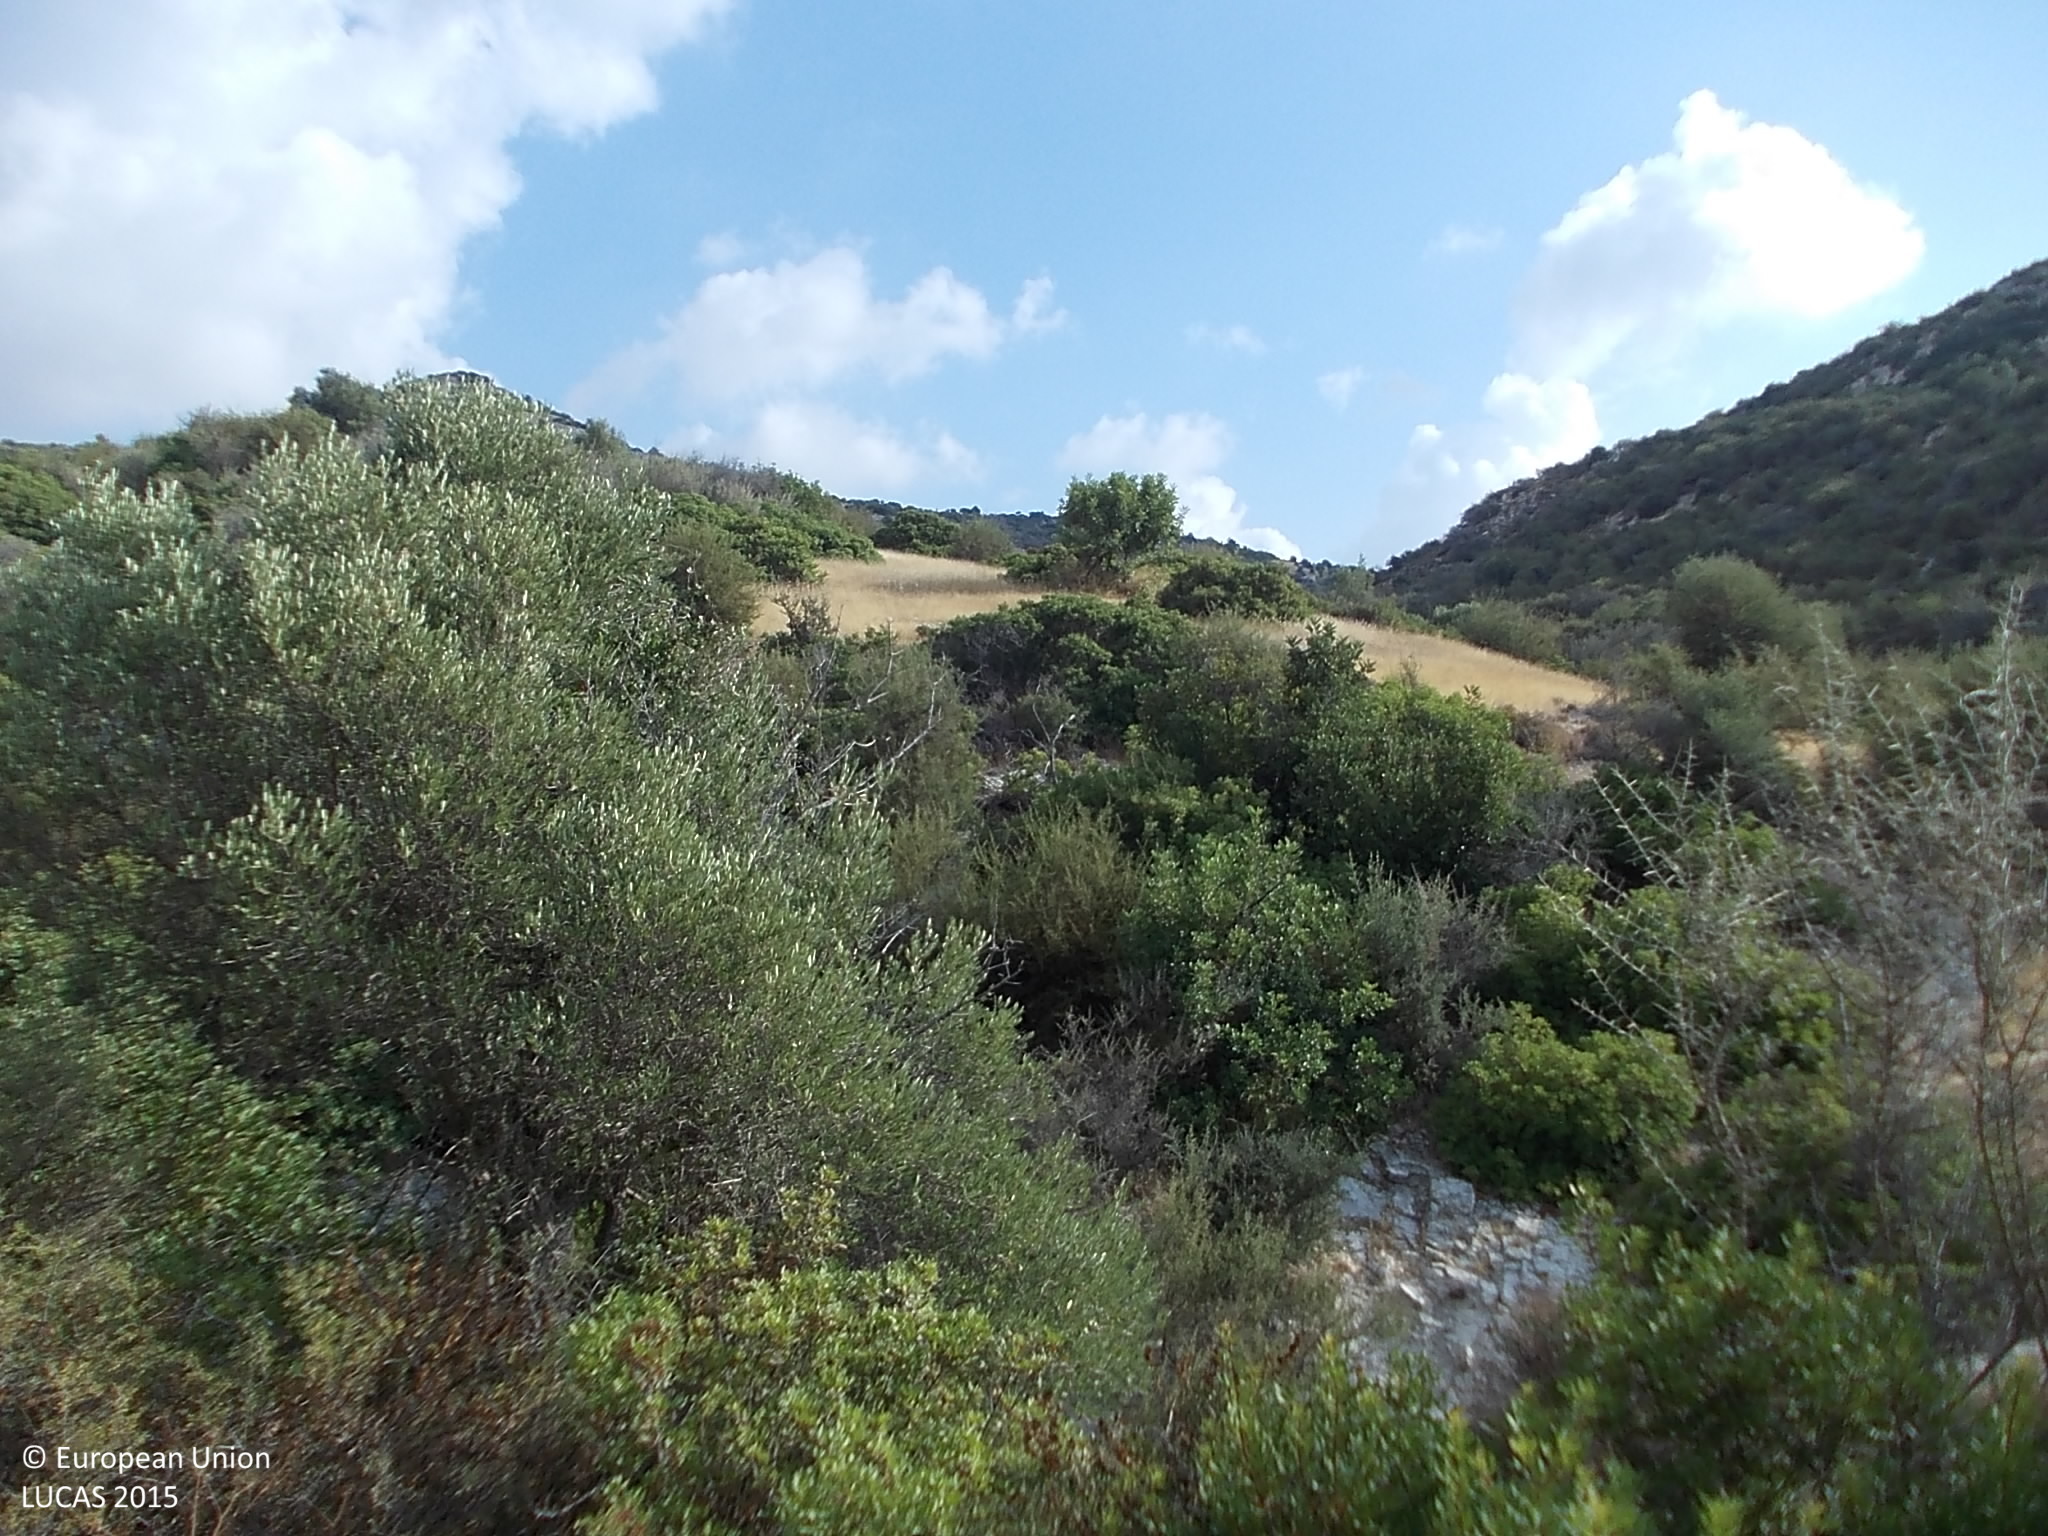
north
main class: Shrubland
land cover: Shrubland with sparse tree cover
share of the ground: > 75 %
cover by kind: shrubs 75 %, herbaceous plants 10 %, unconsolidated bare surface 10 %, broadleaved forest trees 5 %
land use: Semi-natural and natural areas not in use
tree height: < 5 m
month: August
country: CY
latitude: 34.6970
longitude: 32.7177
